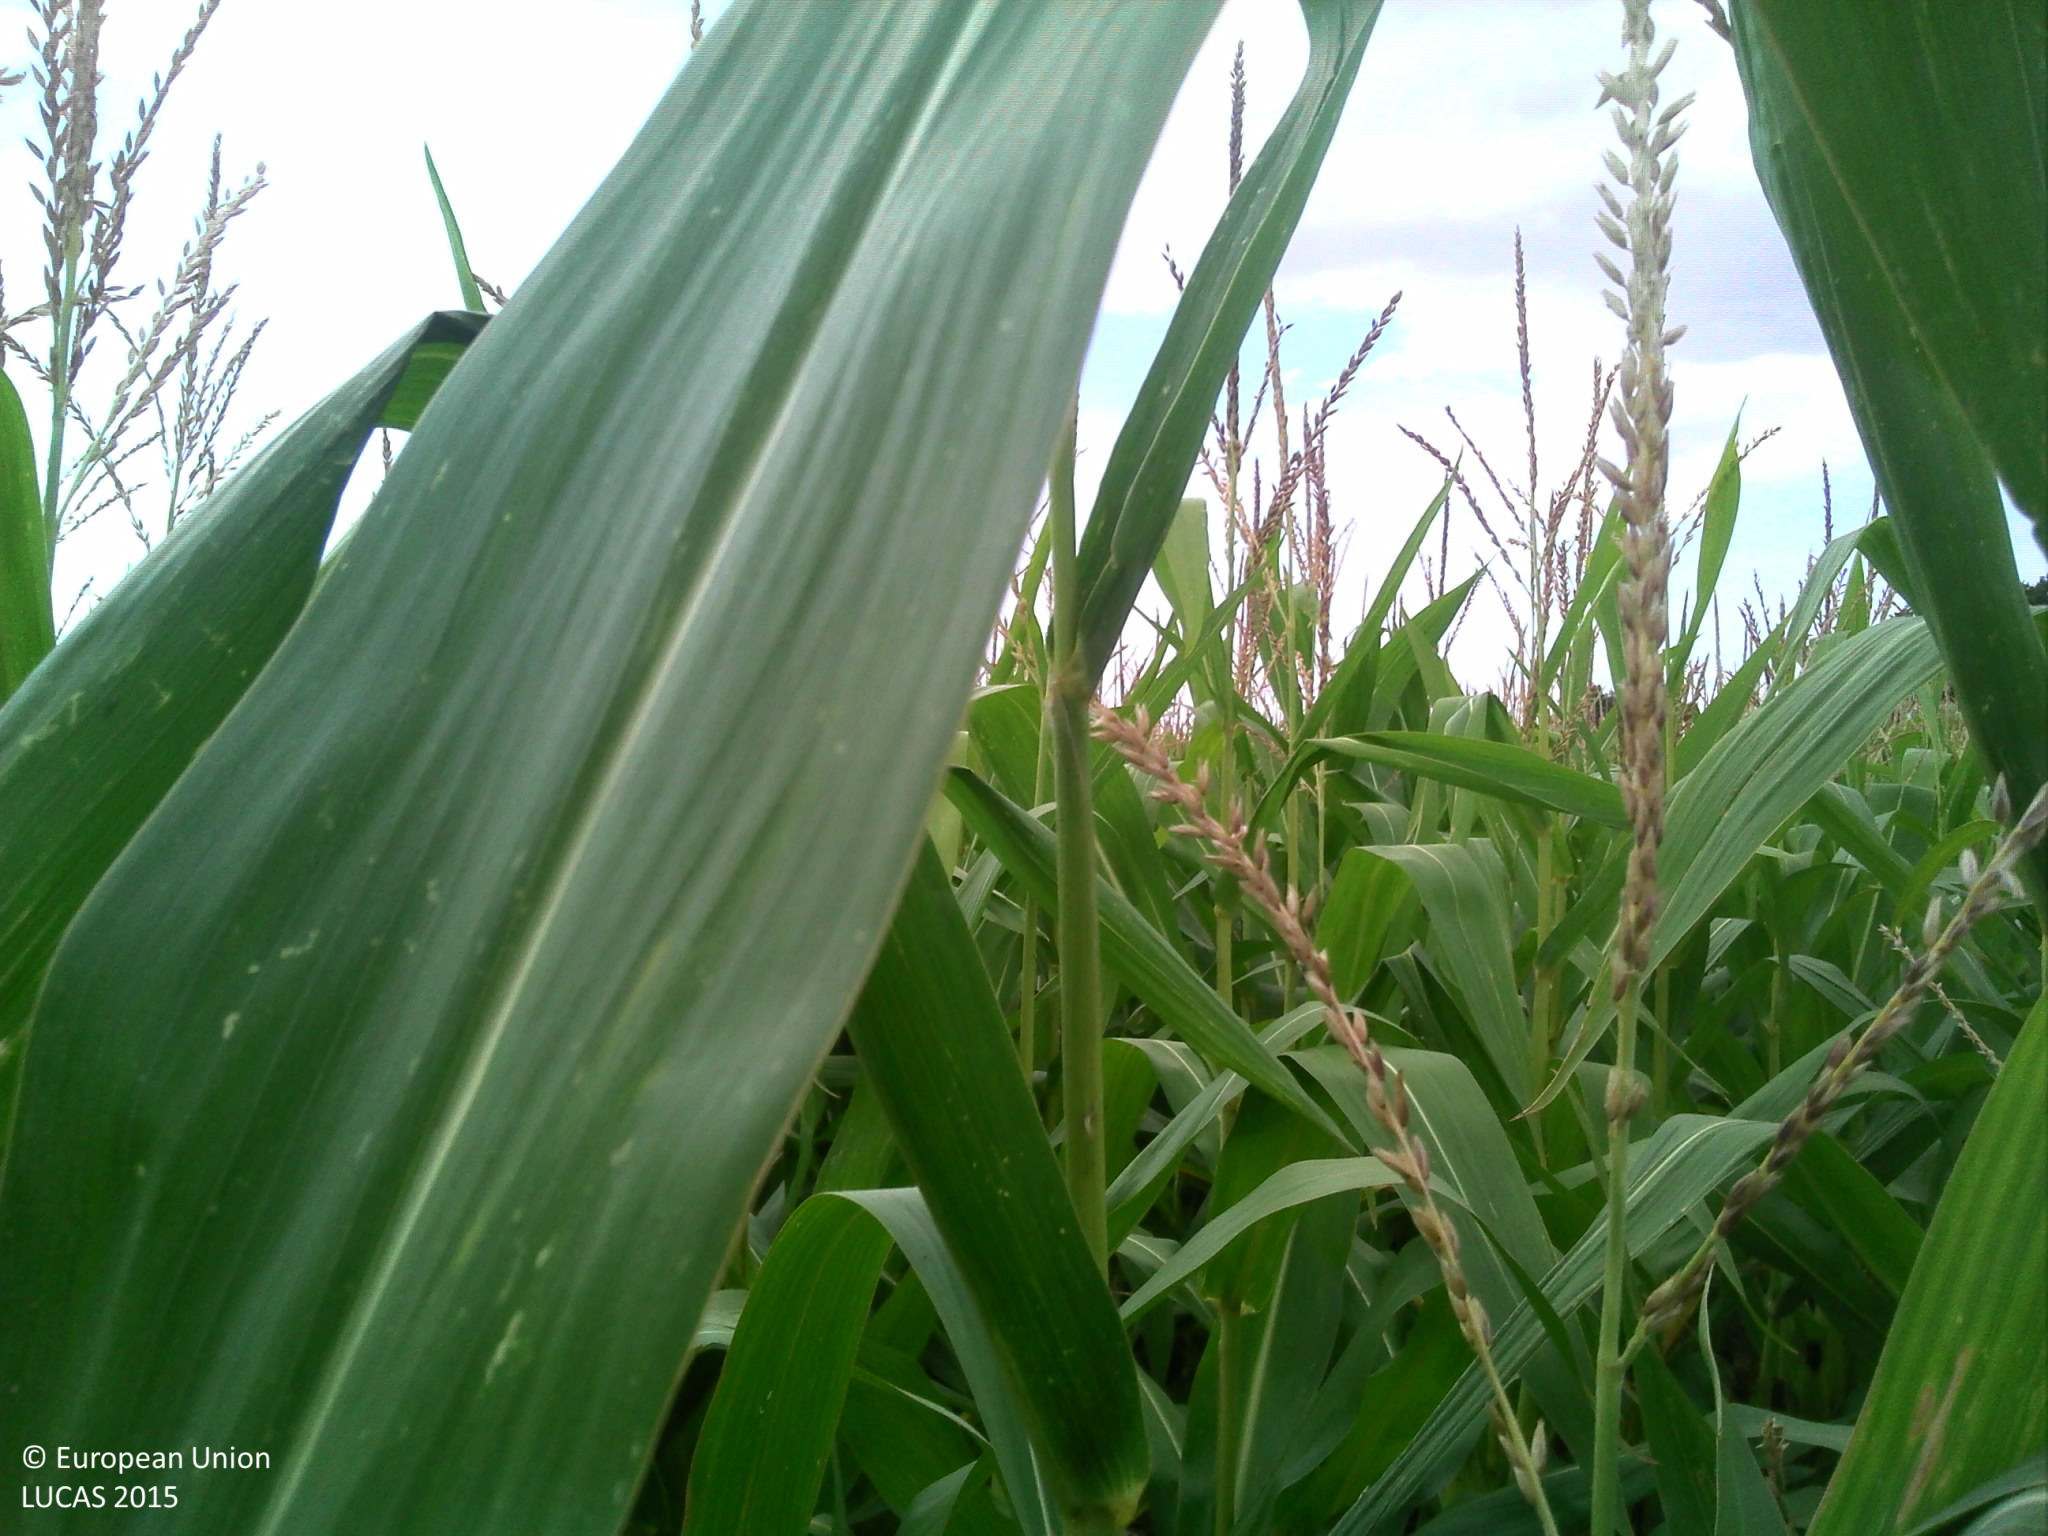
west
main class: Cropland
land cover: Maize
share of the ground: > 75 %
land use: Agriculture (excluding fallow land and kitchen gardens)
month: August
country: FR
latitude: 46.6234
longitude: -1.1217
